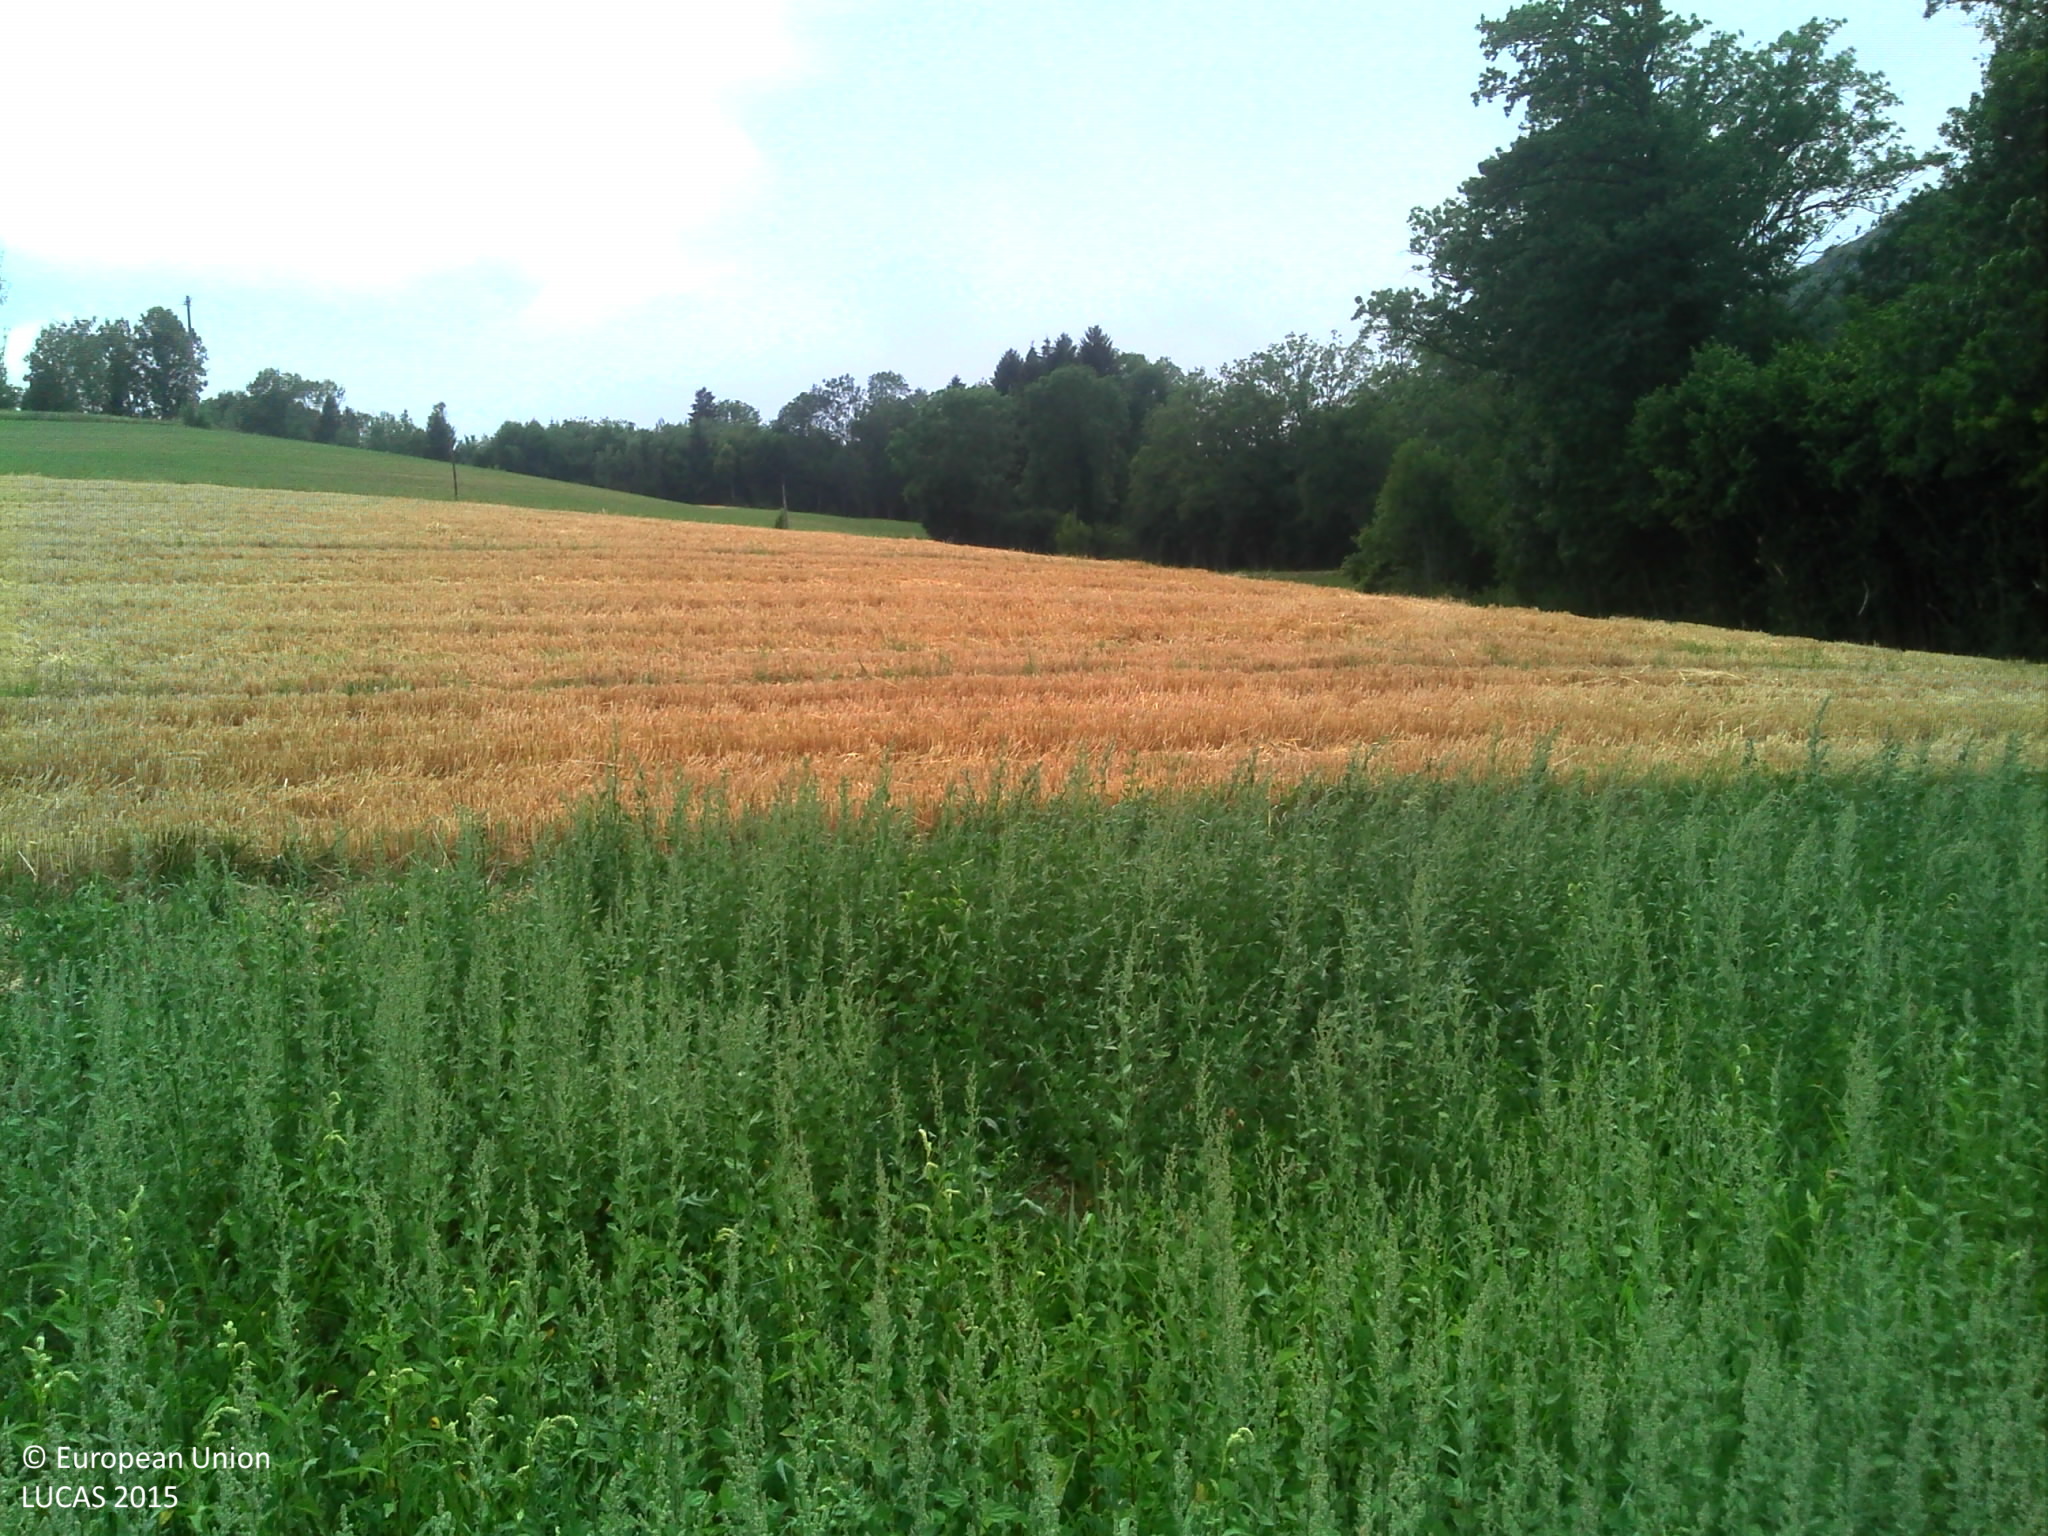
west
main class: Grassland
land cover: Spontaneously vegetated surfaces
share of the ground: > 75 %
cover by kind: herbaceous plants 100 %
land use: Agriculture (excluding fallow land and kitchen gardens)
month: July
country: FR
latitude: 45.9922
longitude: 6.1177
